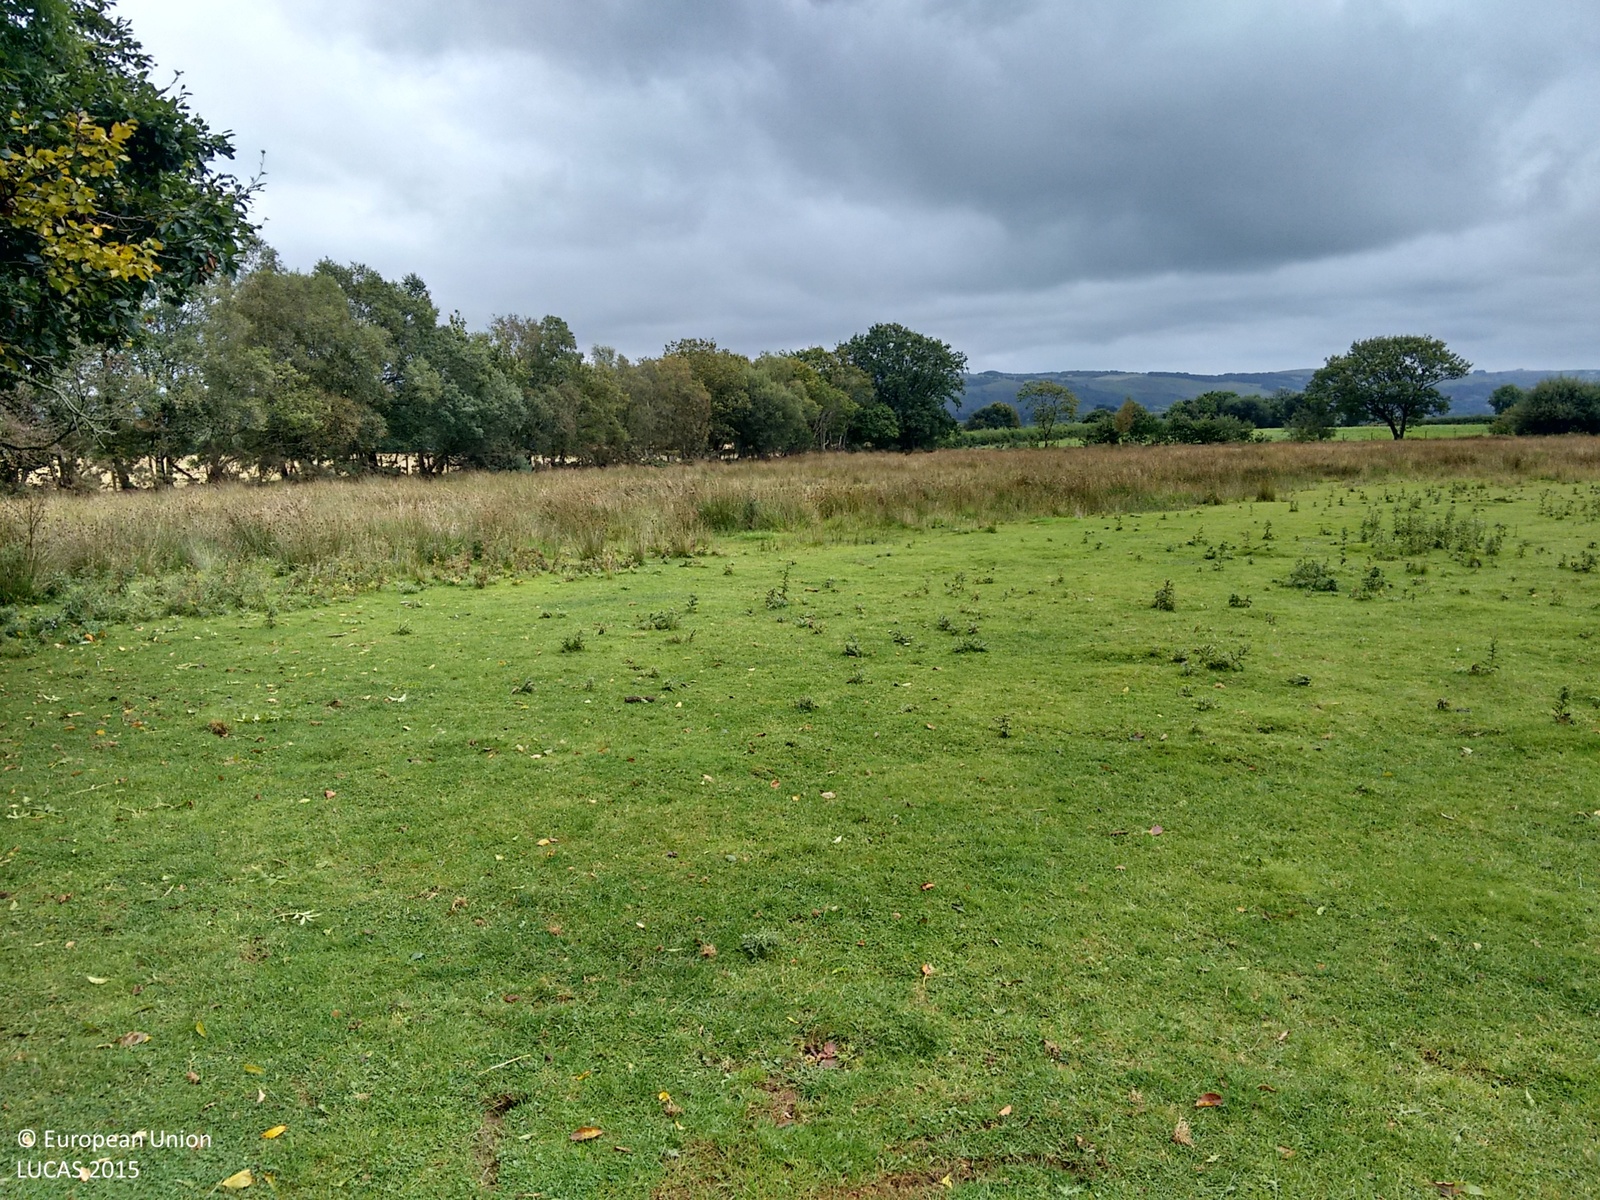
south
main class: Grassland
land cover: Grassland without tree/shrub cover
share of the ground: > 75 %
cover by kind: herbaceous plants 100 %
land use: Agriculture (excluding fallow land and kitchen gardens)
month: September
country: GB
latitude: 52.2021
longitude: -3.9799
